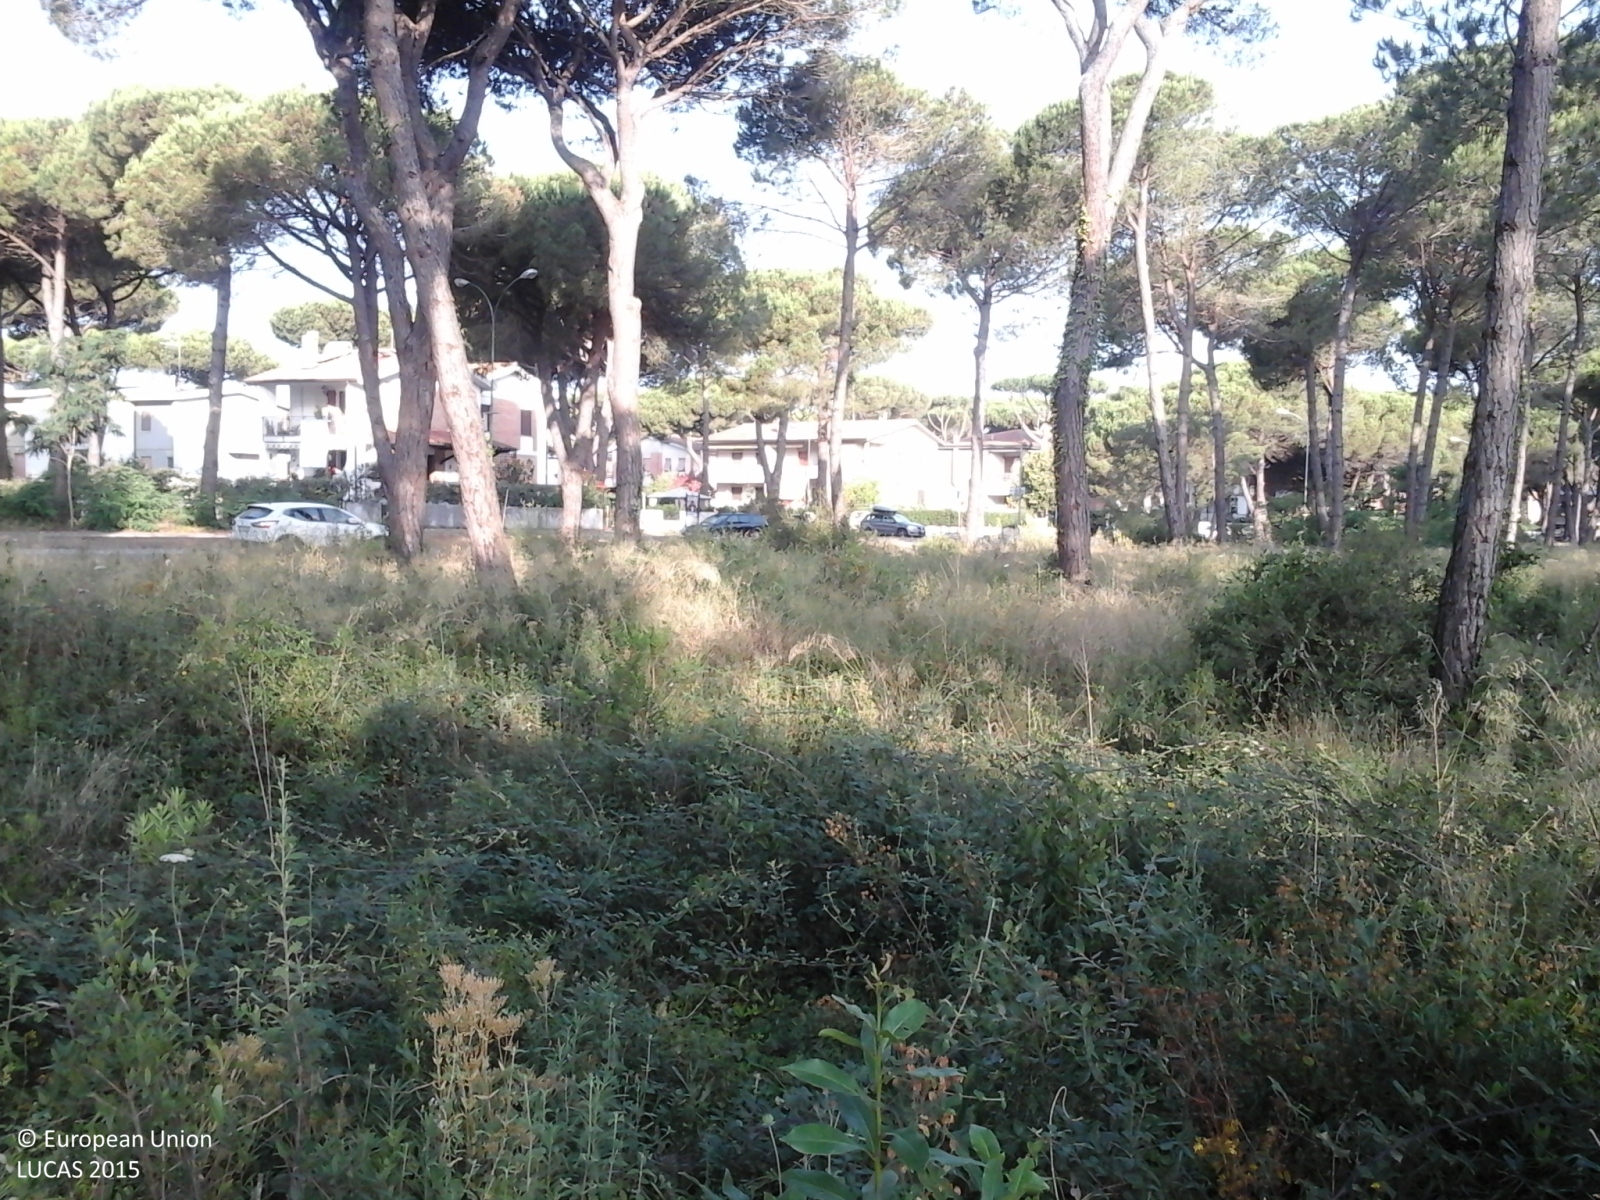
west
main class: Woodland
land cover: Pine dominated coniferous woodland
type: broadleaved evergreen forest
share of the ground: > 75 %
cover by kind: coniferous forest trees 80 %, shrubs 10 %, herbaceous plants 10 %
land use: Forestry
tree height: > 5 m
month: July
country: IT
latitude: 42.7215
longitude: 10.9859
